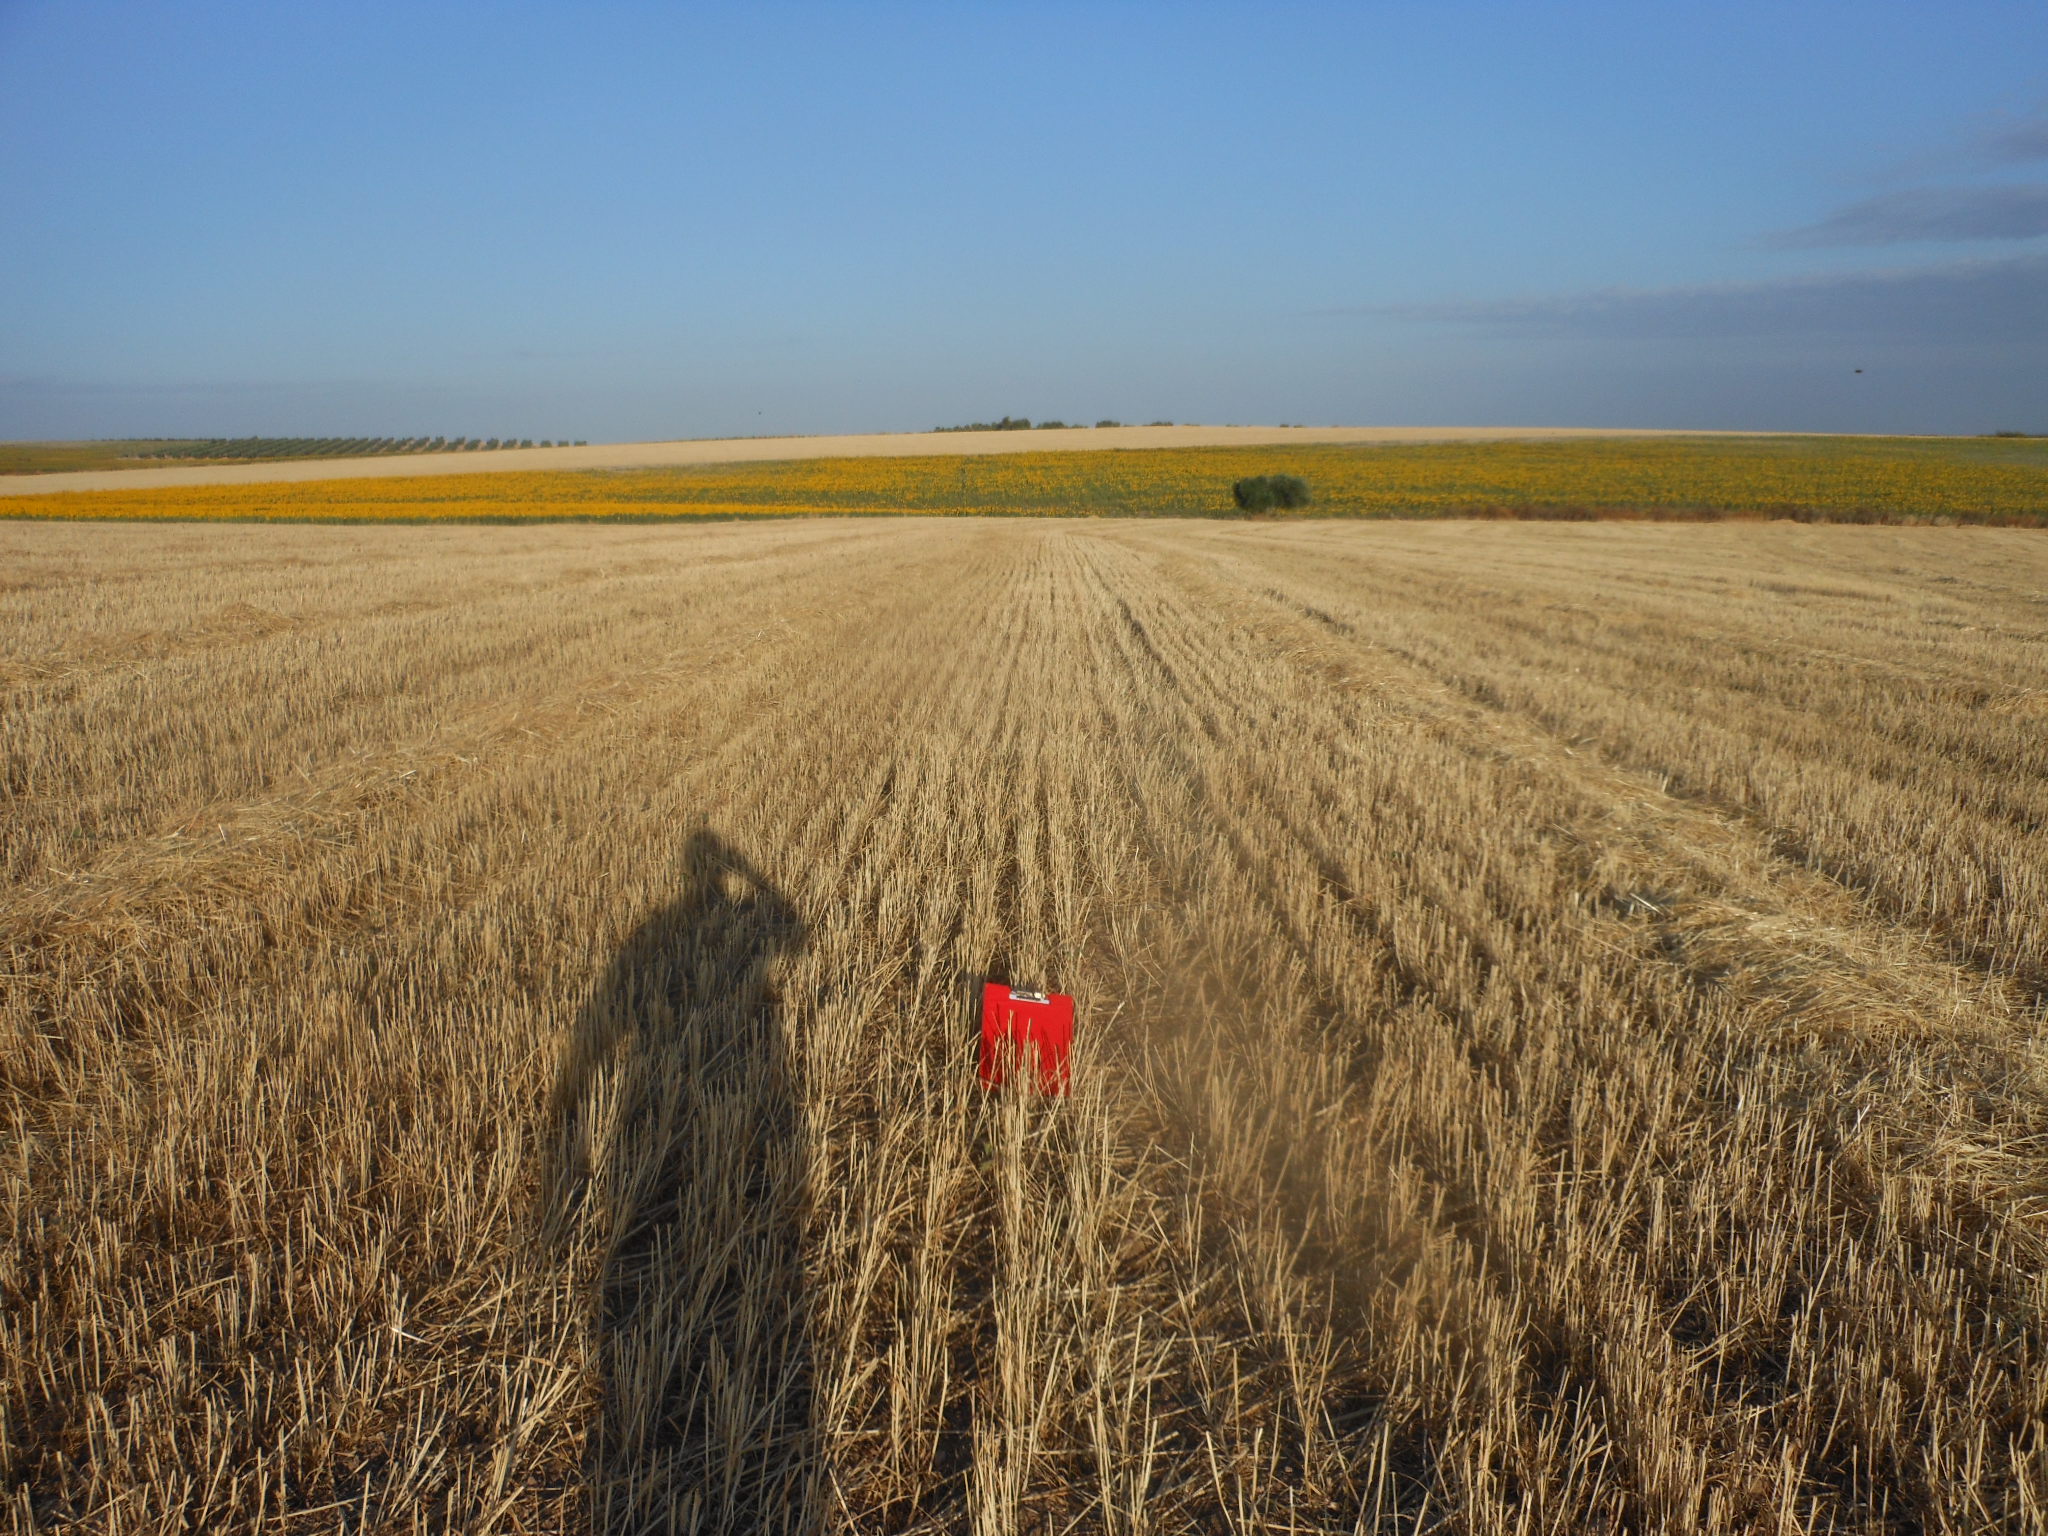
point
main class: Cropland
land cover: Common wheat
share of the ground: < 10 %
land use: Agriculture (excluding fallow land and kitchen gardens)
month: June
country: ES
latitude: 37.2800
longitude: -5.0417
